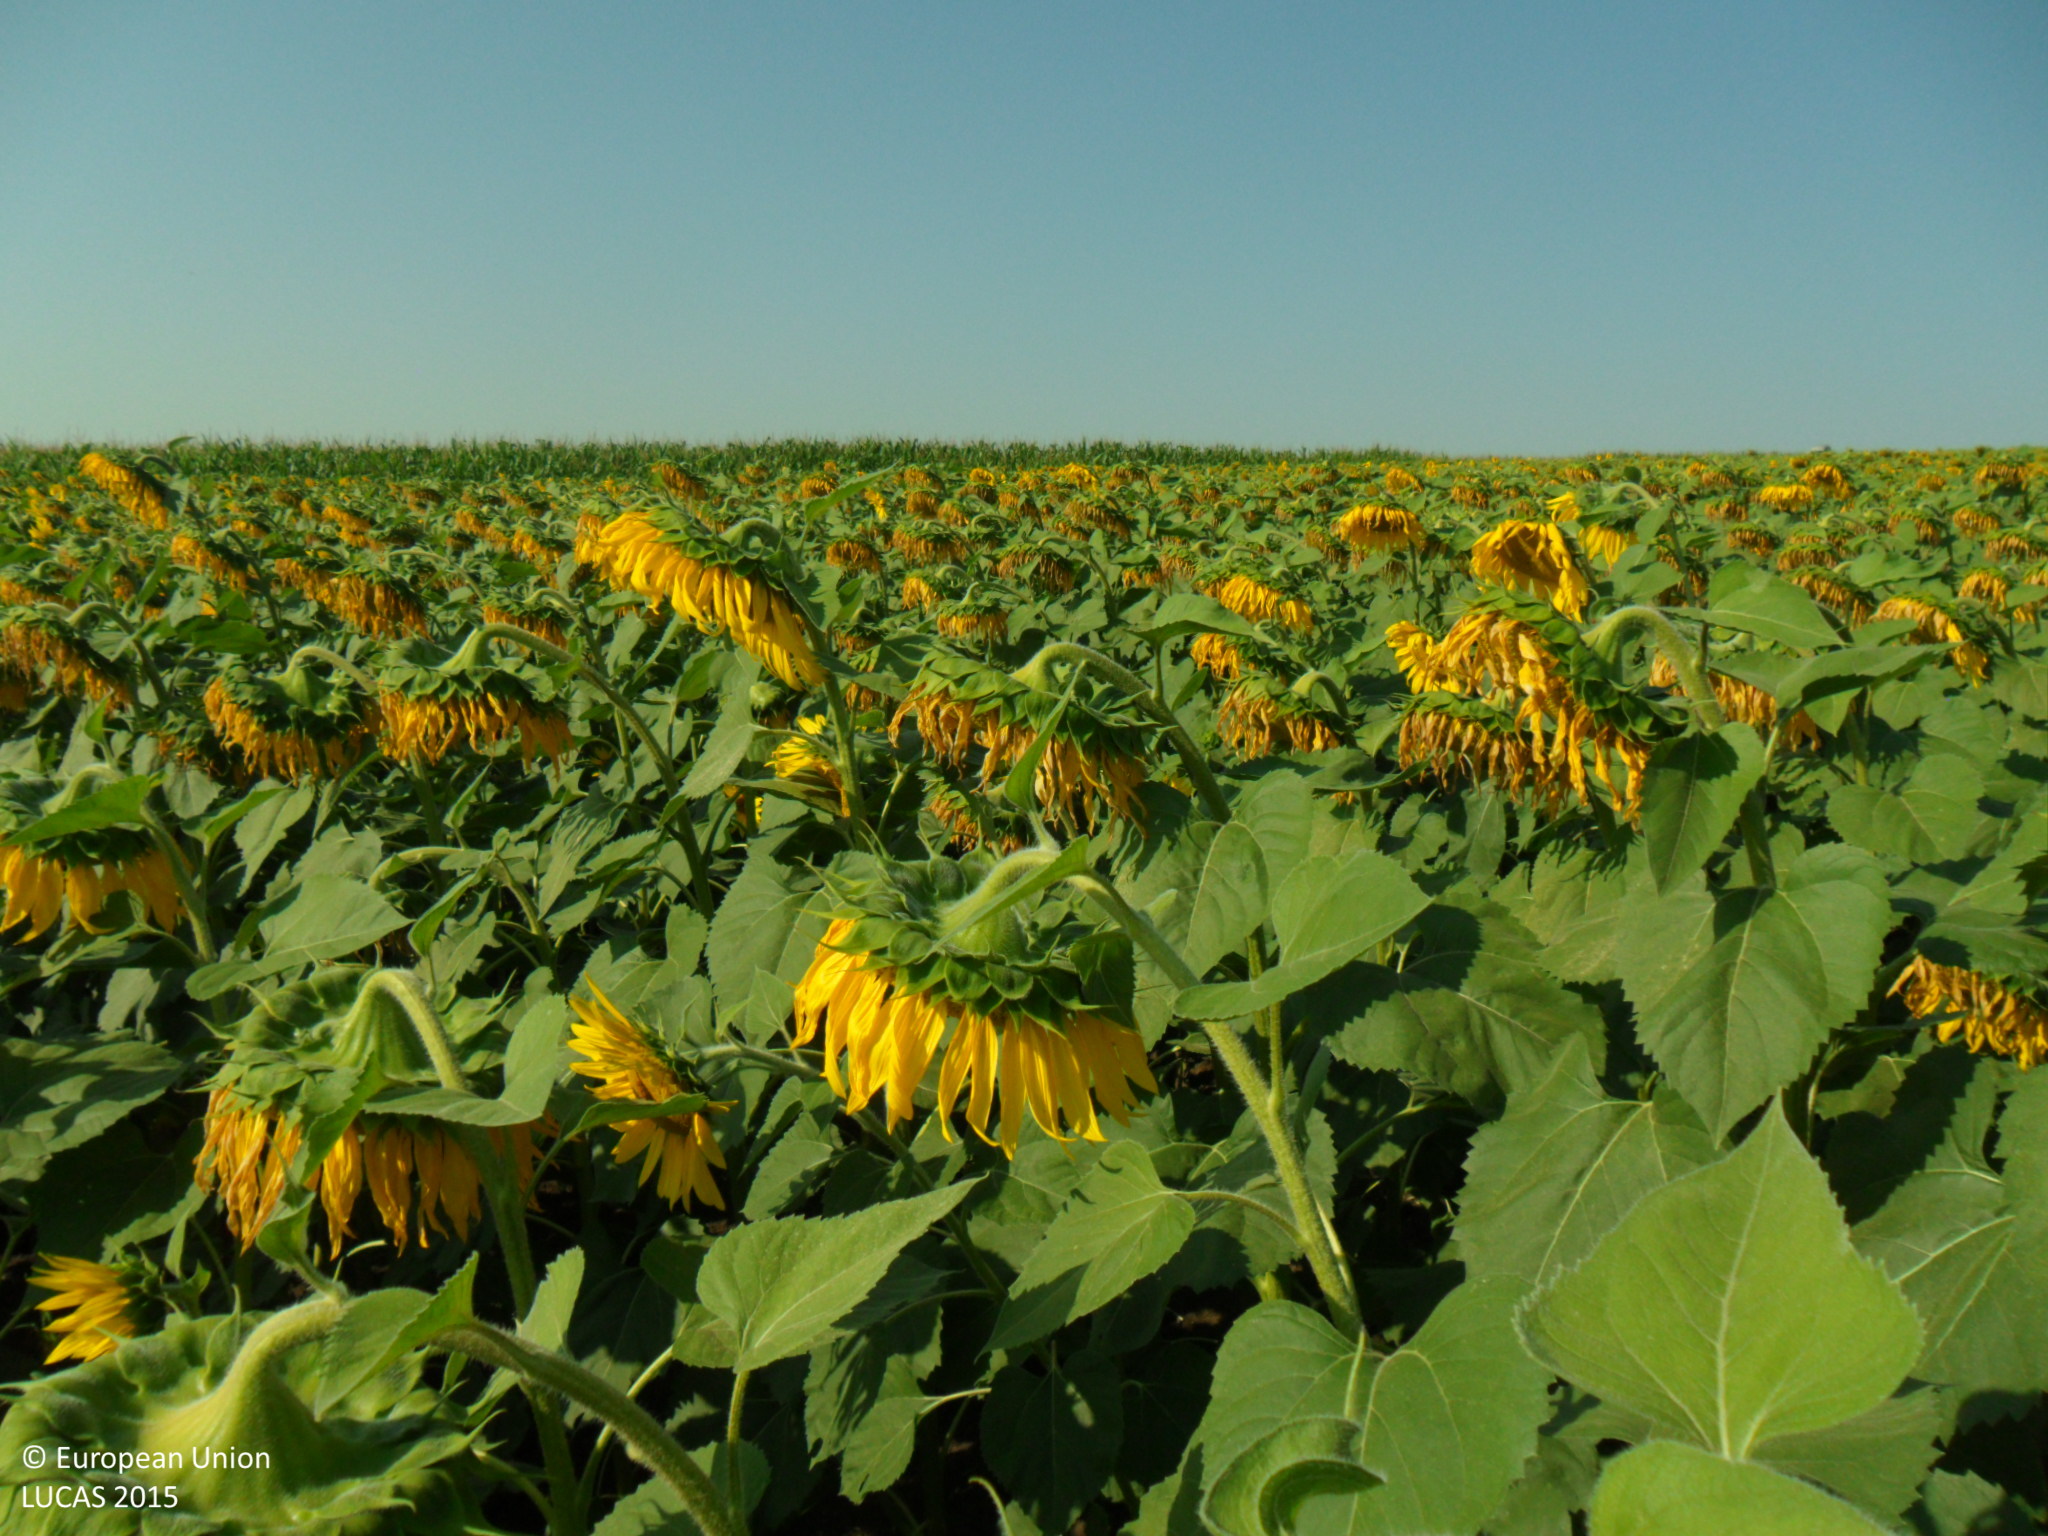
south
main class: Cropland
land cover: Sunflower
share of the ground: > 75 %
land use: Agriculture (excluding fallow land and kitchen gardens)
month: July
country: BG
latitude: 43.5973
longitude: 27.4356
